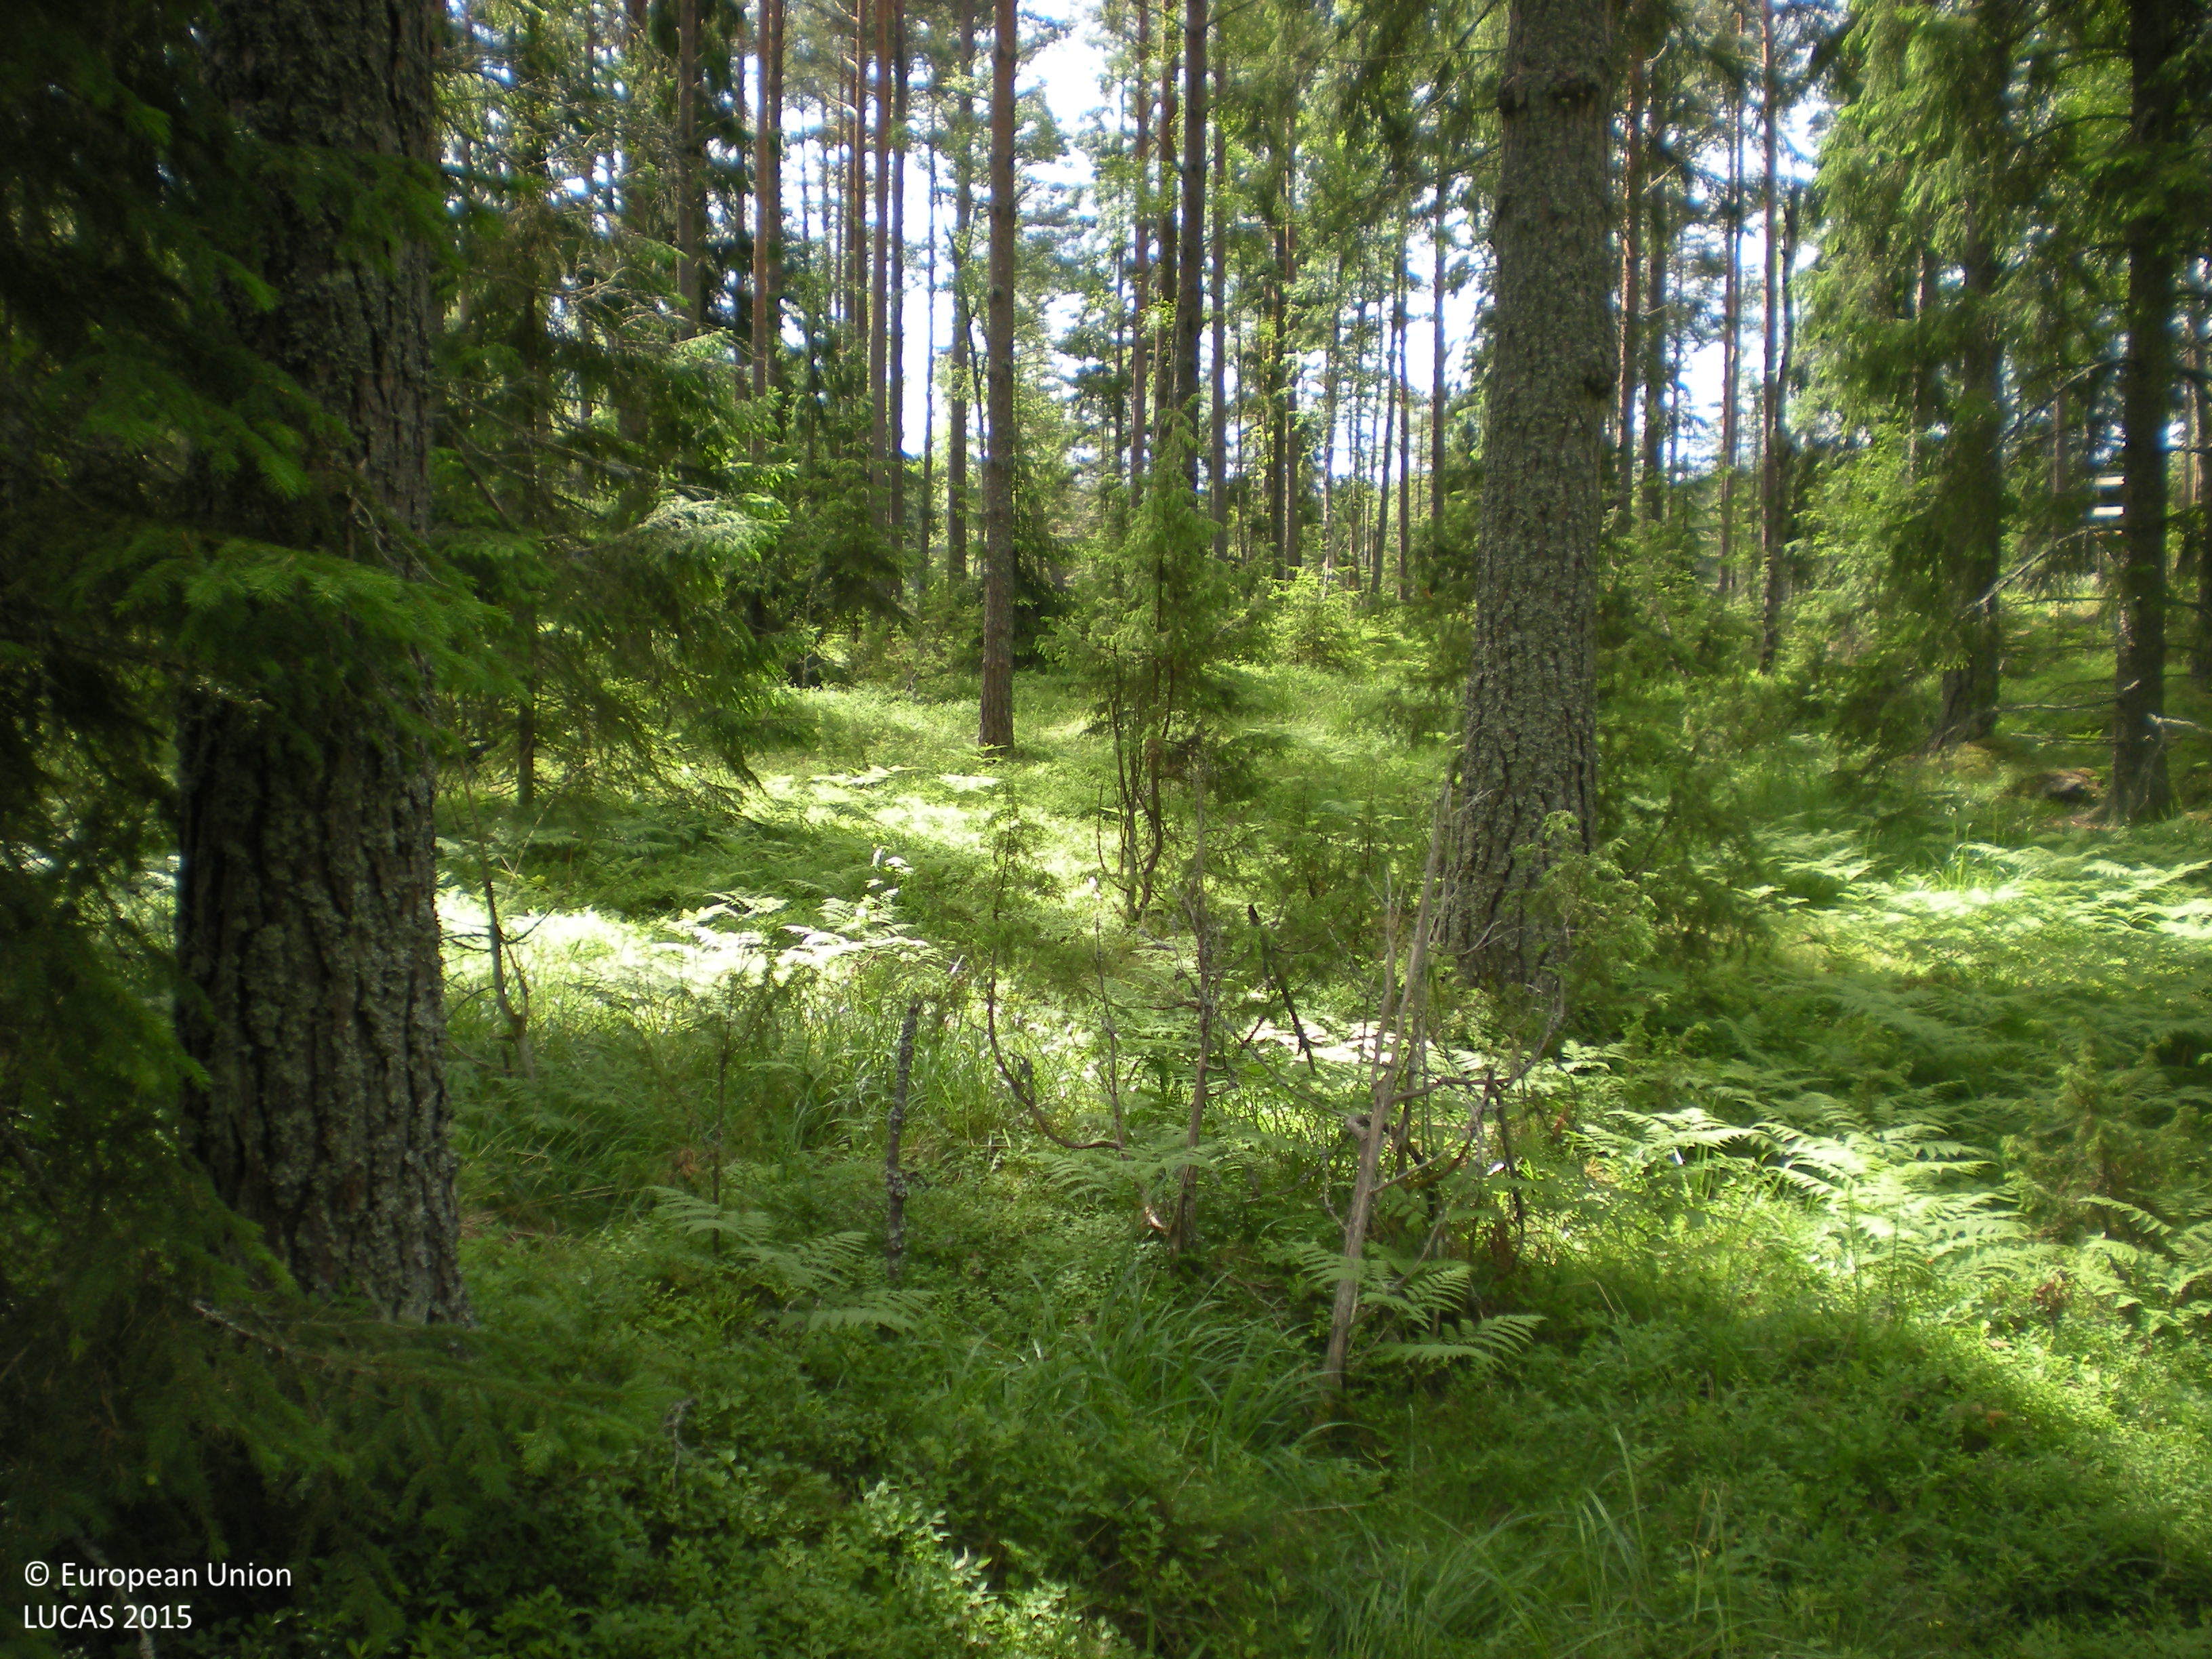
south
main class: Woodland
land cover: Pine dominated coniferous woodland
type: boreal forest
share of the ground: 50 - 75 %
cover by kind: coniferous forest trees 70 %, shrubs 20 %, herbaceous plants 5 %, lichens and mosses 5 %
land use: Forestry
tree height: > 5 m
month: June
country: SE
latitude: 60.4577
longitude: 18.0477
